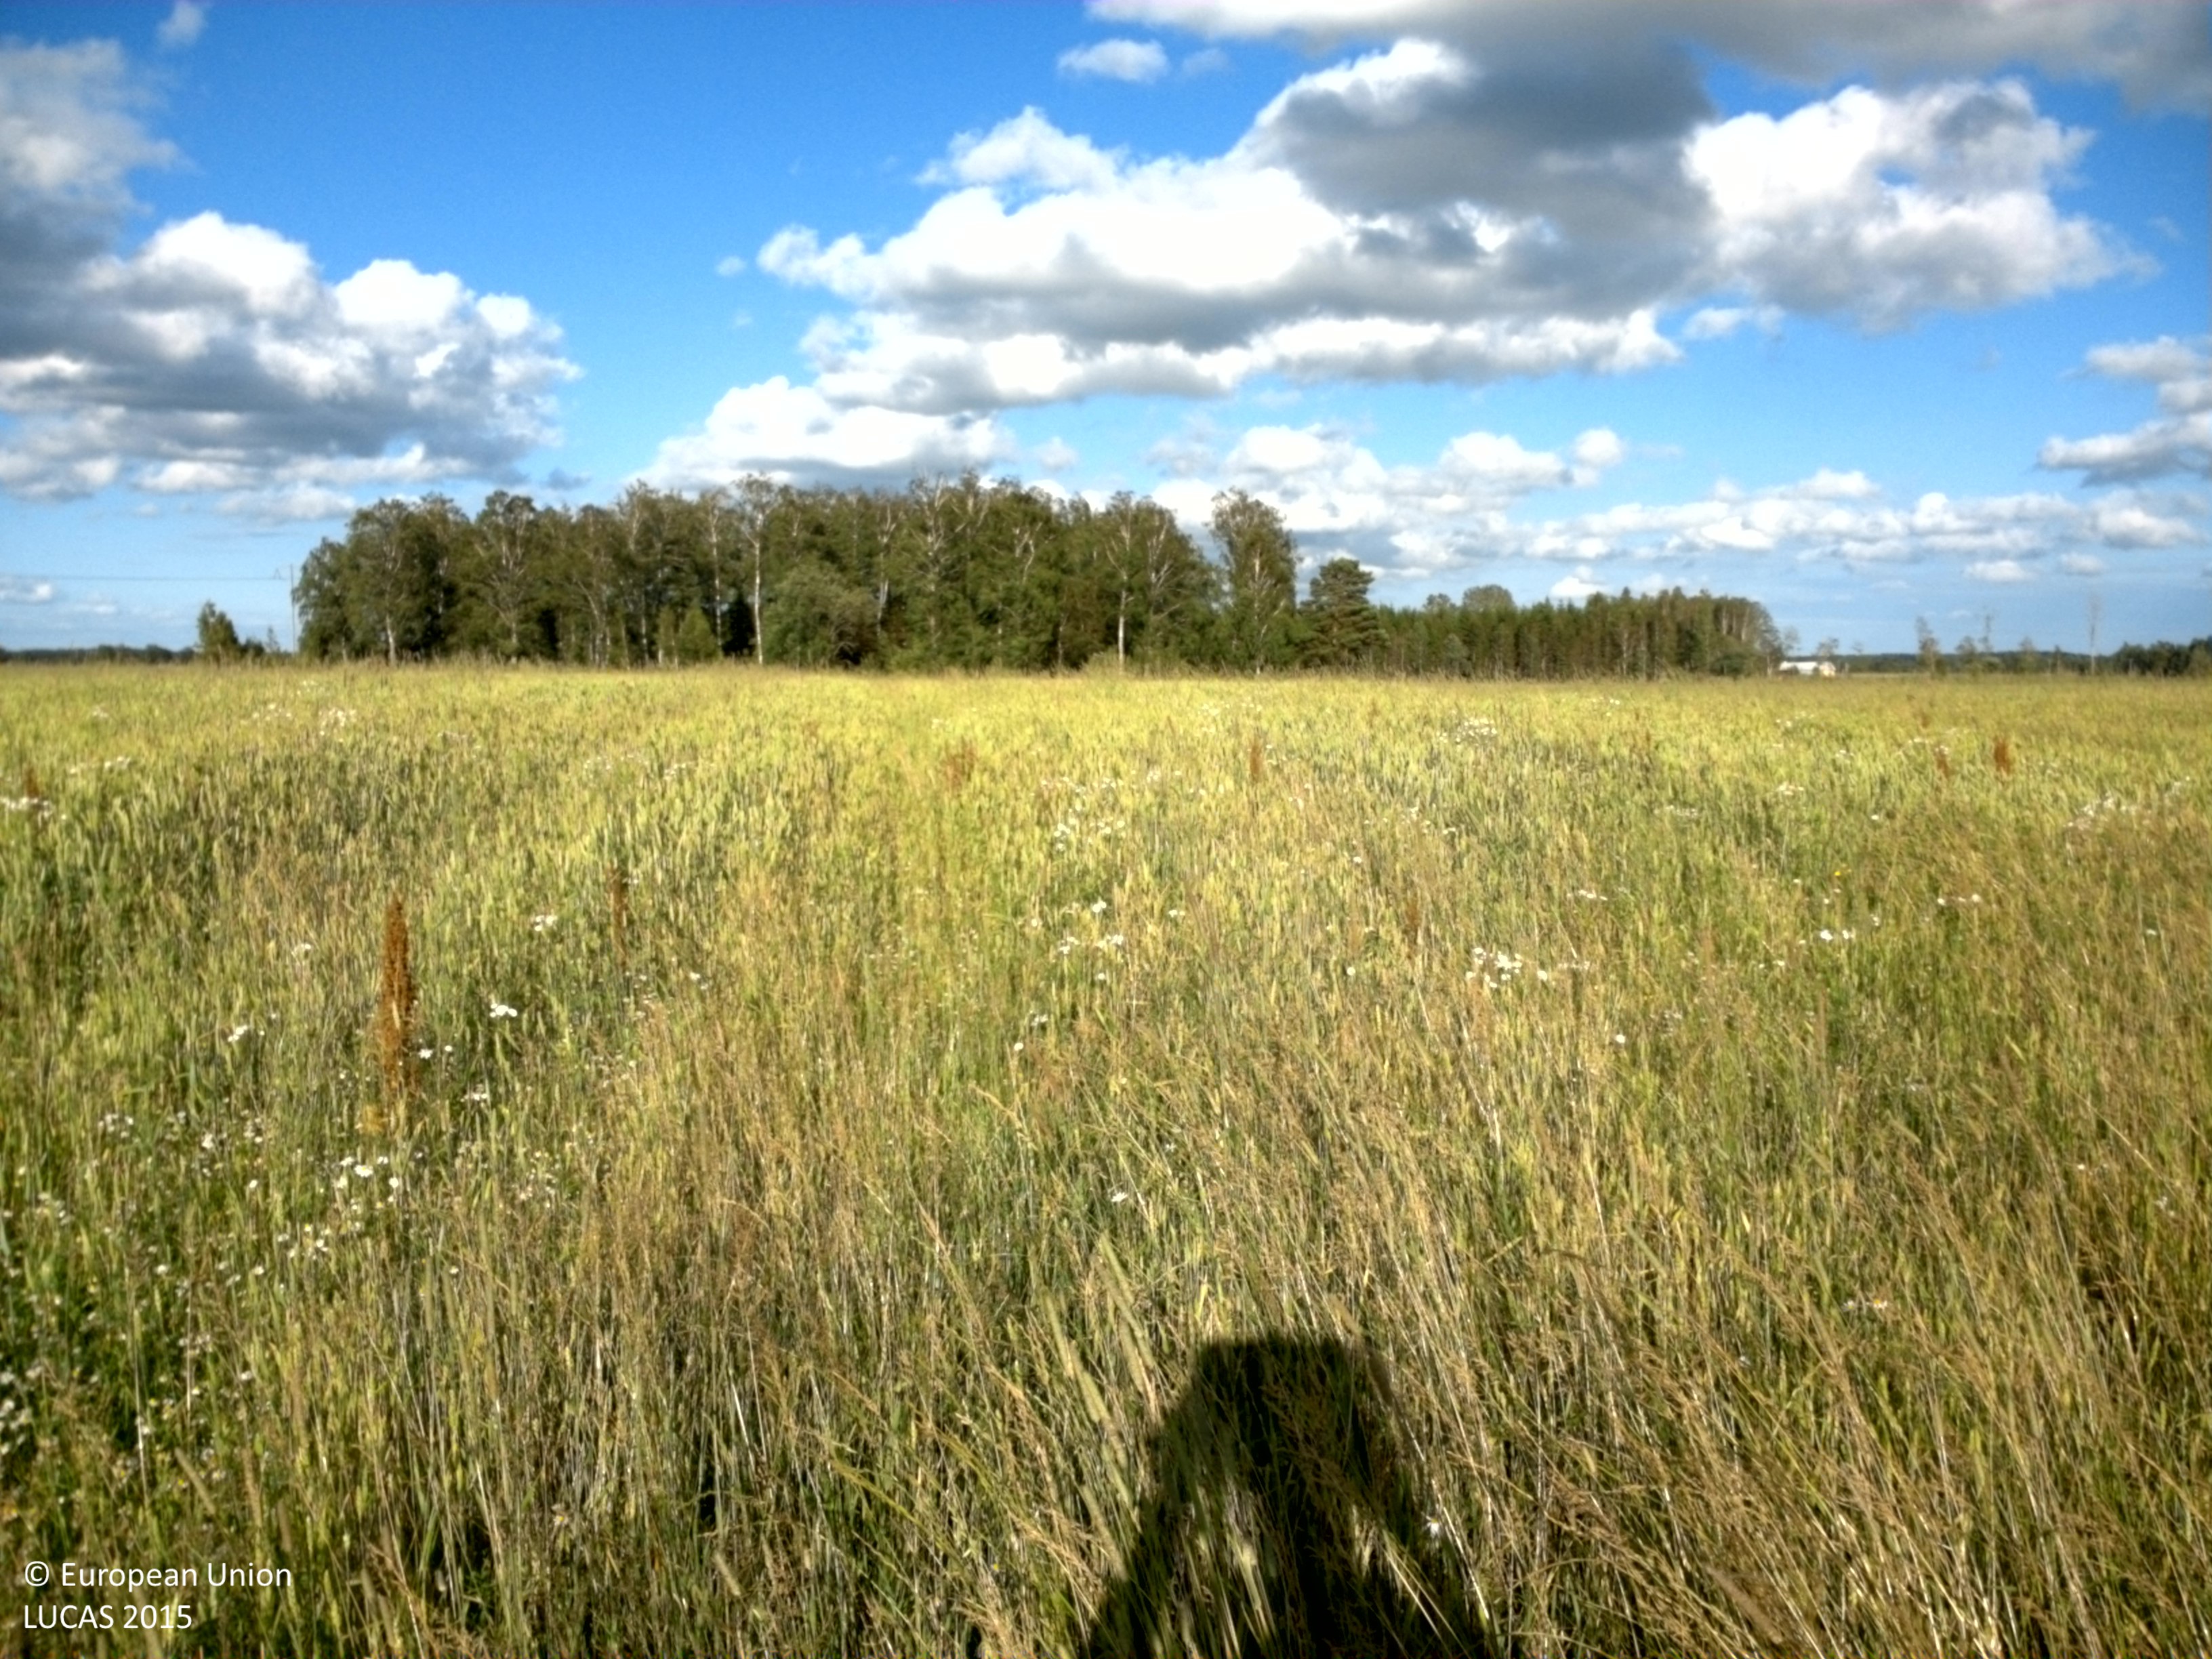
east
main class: Cropland
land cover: Common wheat
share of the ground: > 75 %
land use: Agriculture (excluding fallow land and kitchen gardens)
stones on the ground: > 50 %
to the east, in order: Common wheat; Ditches and canals; Fences; Spruce dominated mixed woodland; Broadleaved woodland; Spruce dominated mixed woodland; Fences; Ditches and canals; Grass margins; Common wheat
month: July
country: SE
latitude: 58.3788
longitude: 13.9098
